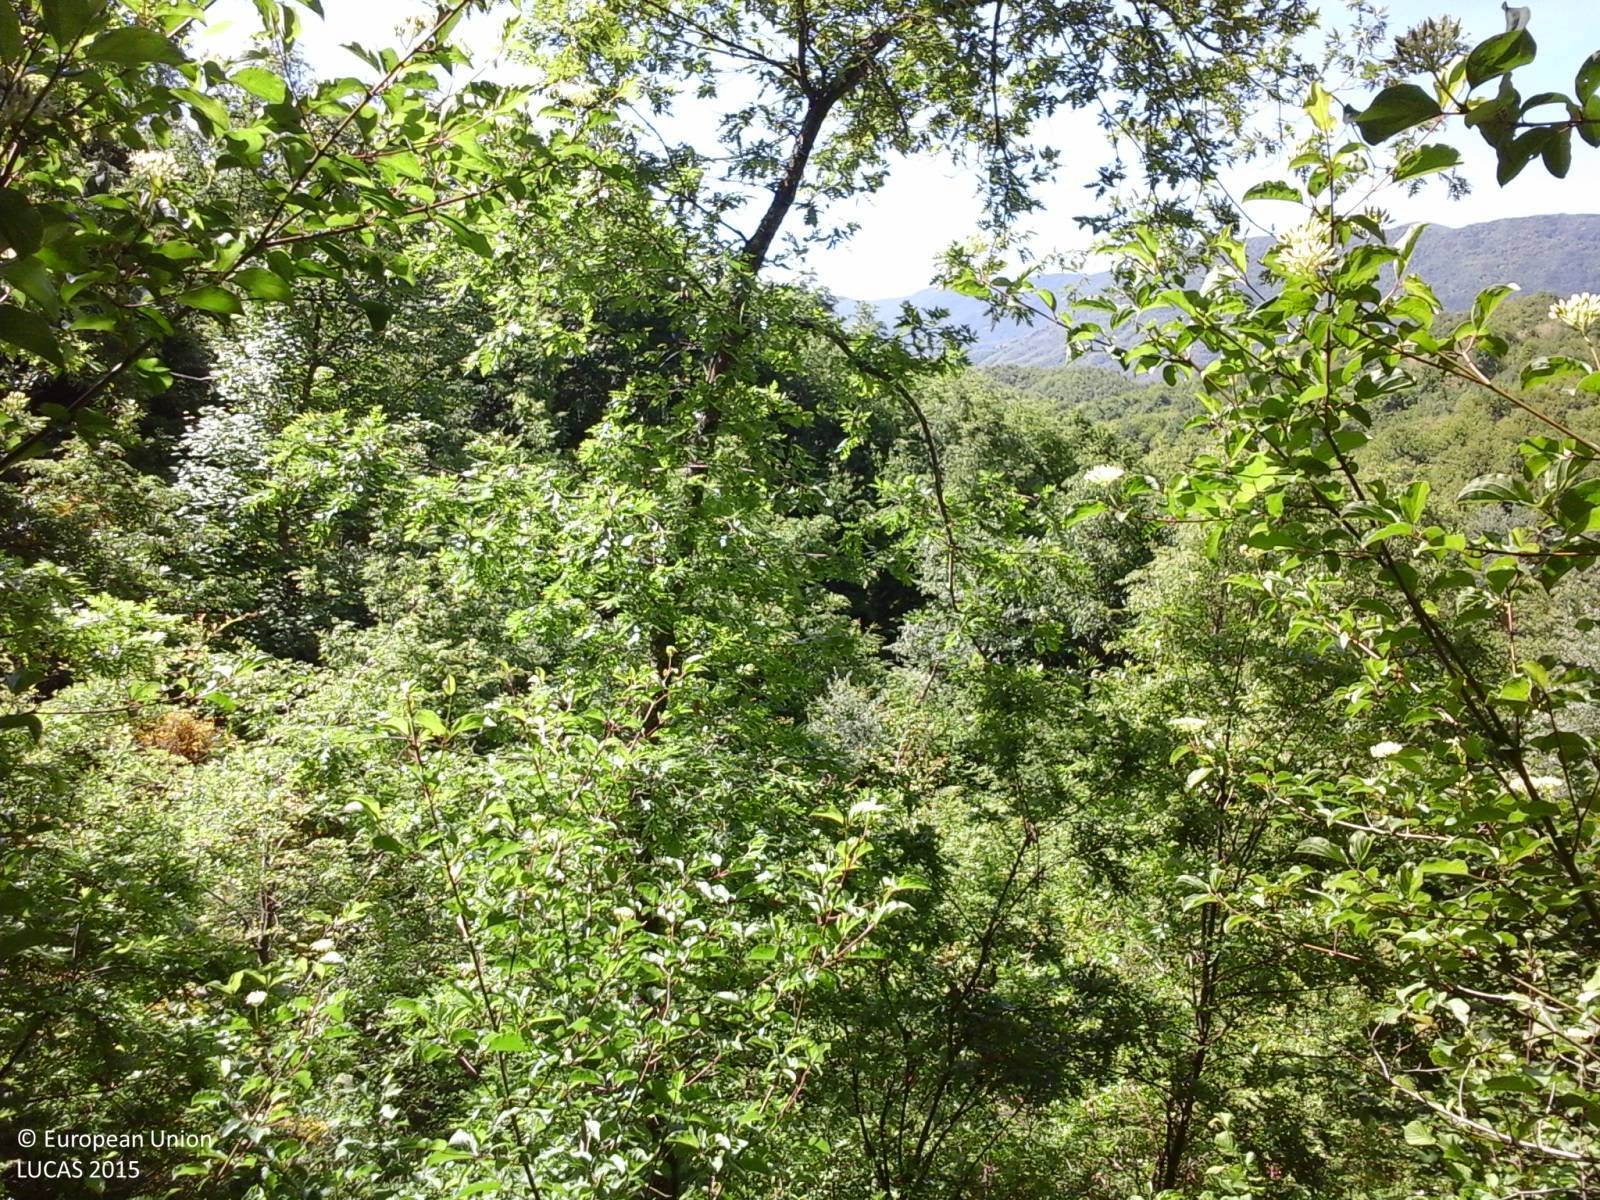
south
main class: Woodland
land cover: Broadleaved woodland
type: thermophilous deciduous forest
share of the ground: > 75 %
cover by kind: broadleaved forest trees 90 %, shrubs 5 %, herbaceous plants 5 %
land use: Forestry
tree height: > 5 m
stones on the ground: < 10 %
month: May
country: IT
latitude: 42.1148
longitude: 13.2182
